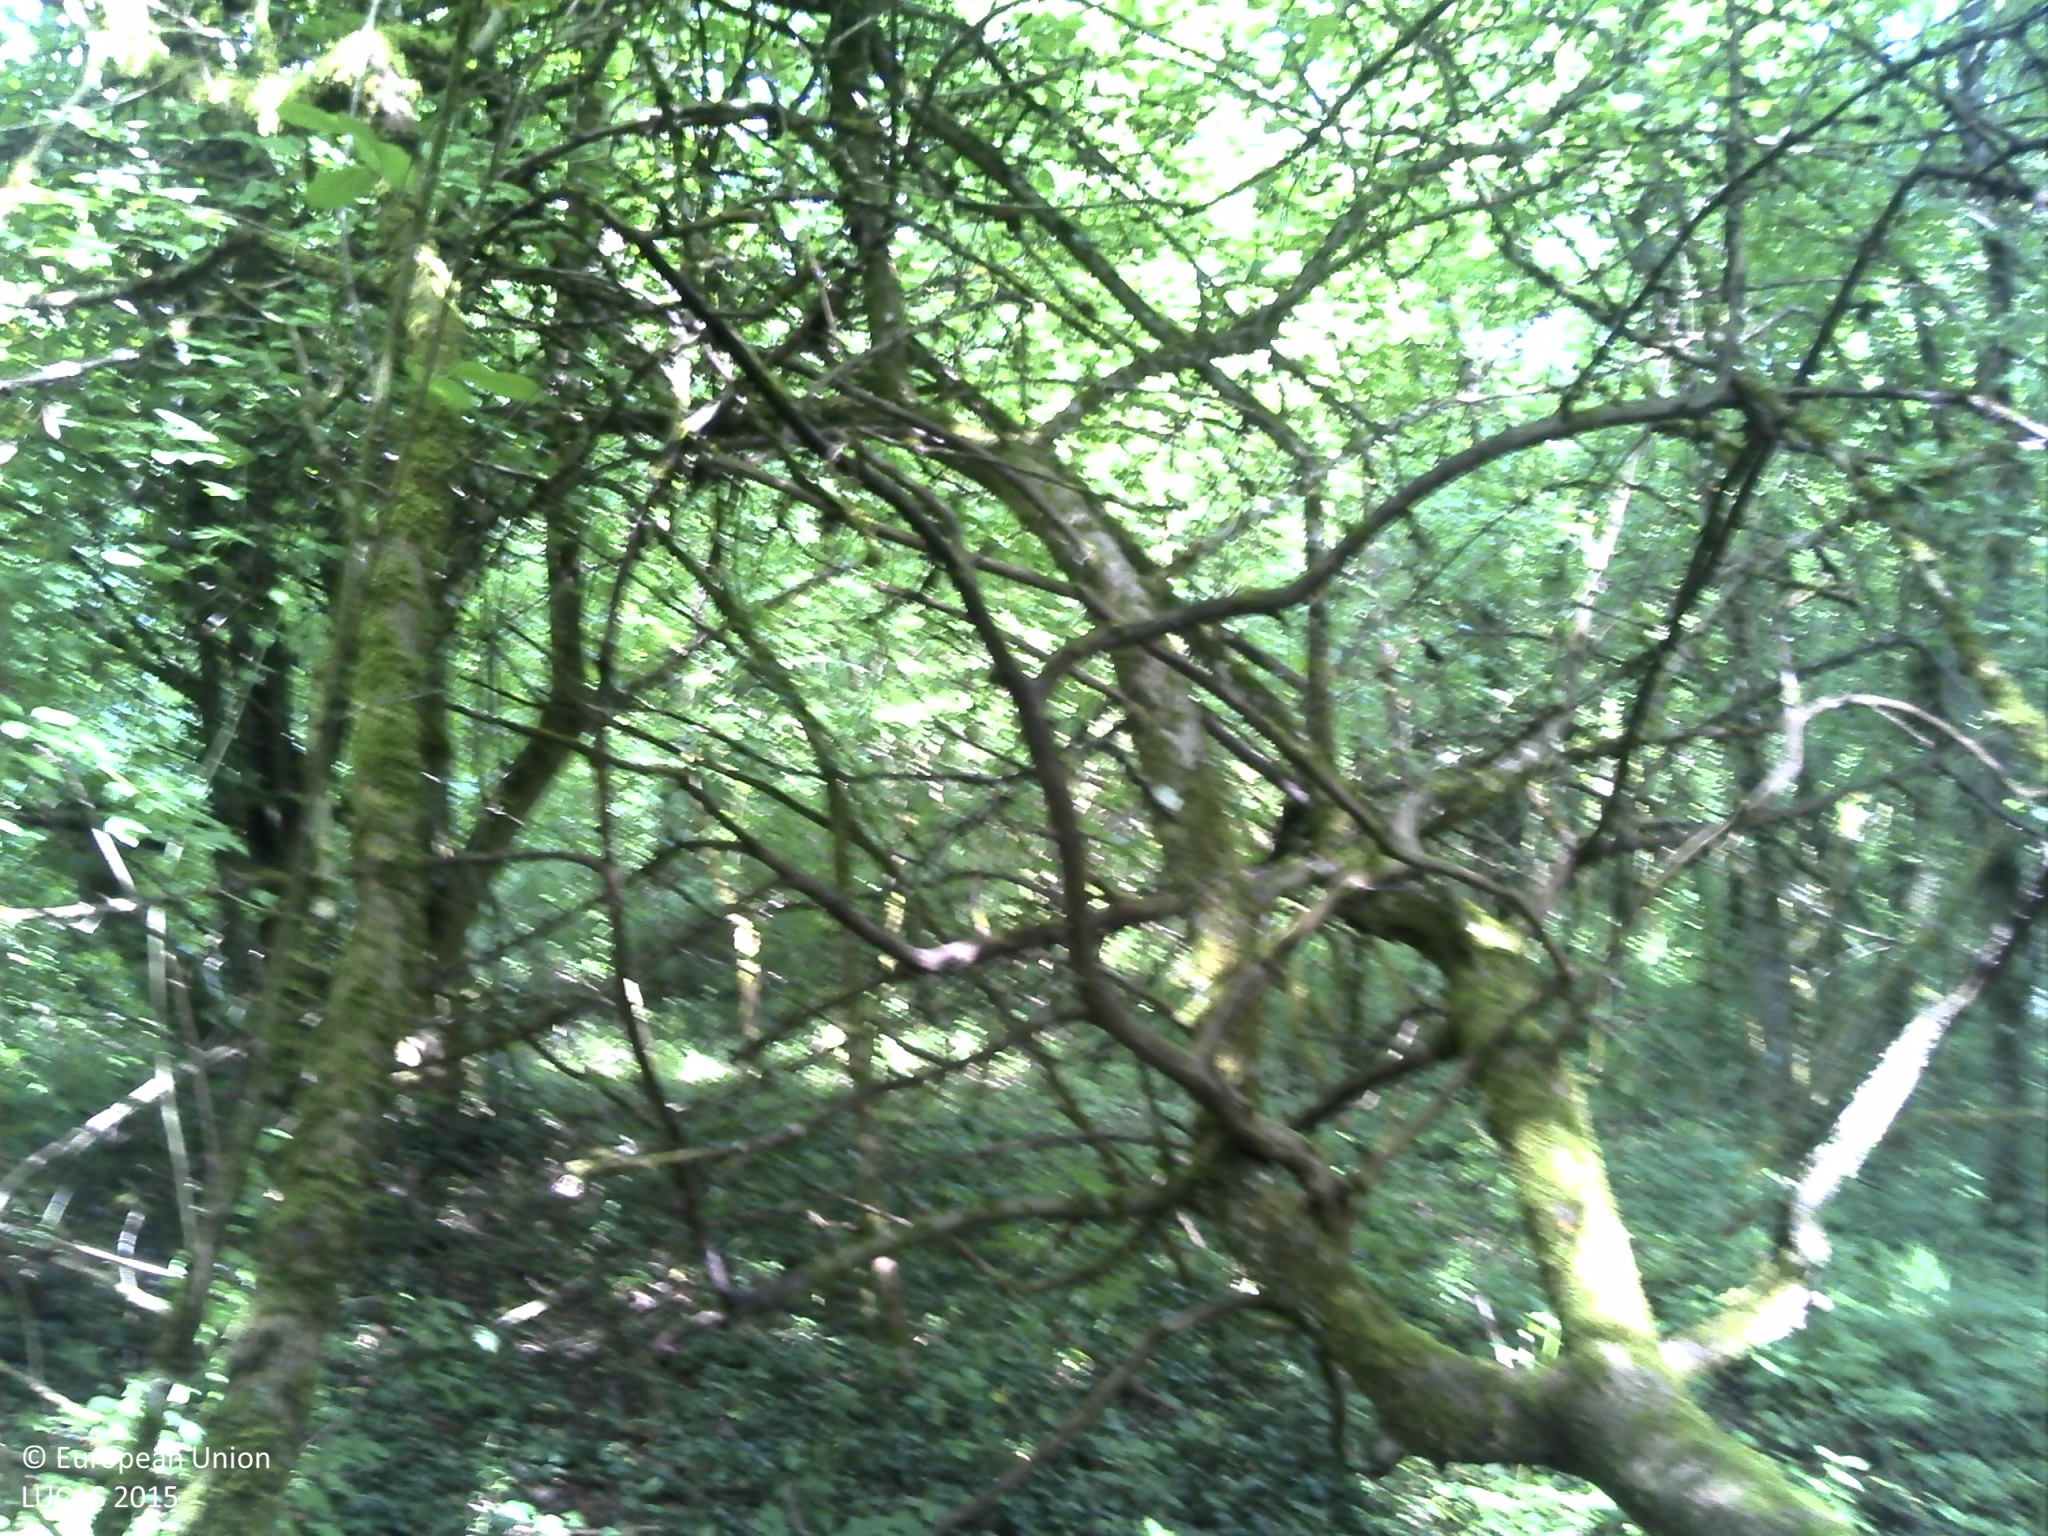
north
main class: Woodland
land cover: Broadleaved woodland
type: non-riverine alder, birch or aspen forest
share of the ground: > 75 %
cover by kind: broadleaved forest trees 90 %, shrubs 10 %
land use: Semi-natural and natural areas not in use
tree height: > 5 m
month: June
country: FR
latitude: 49.2527
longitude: 6.0840
